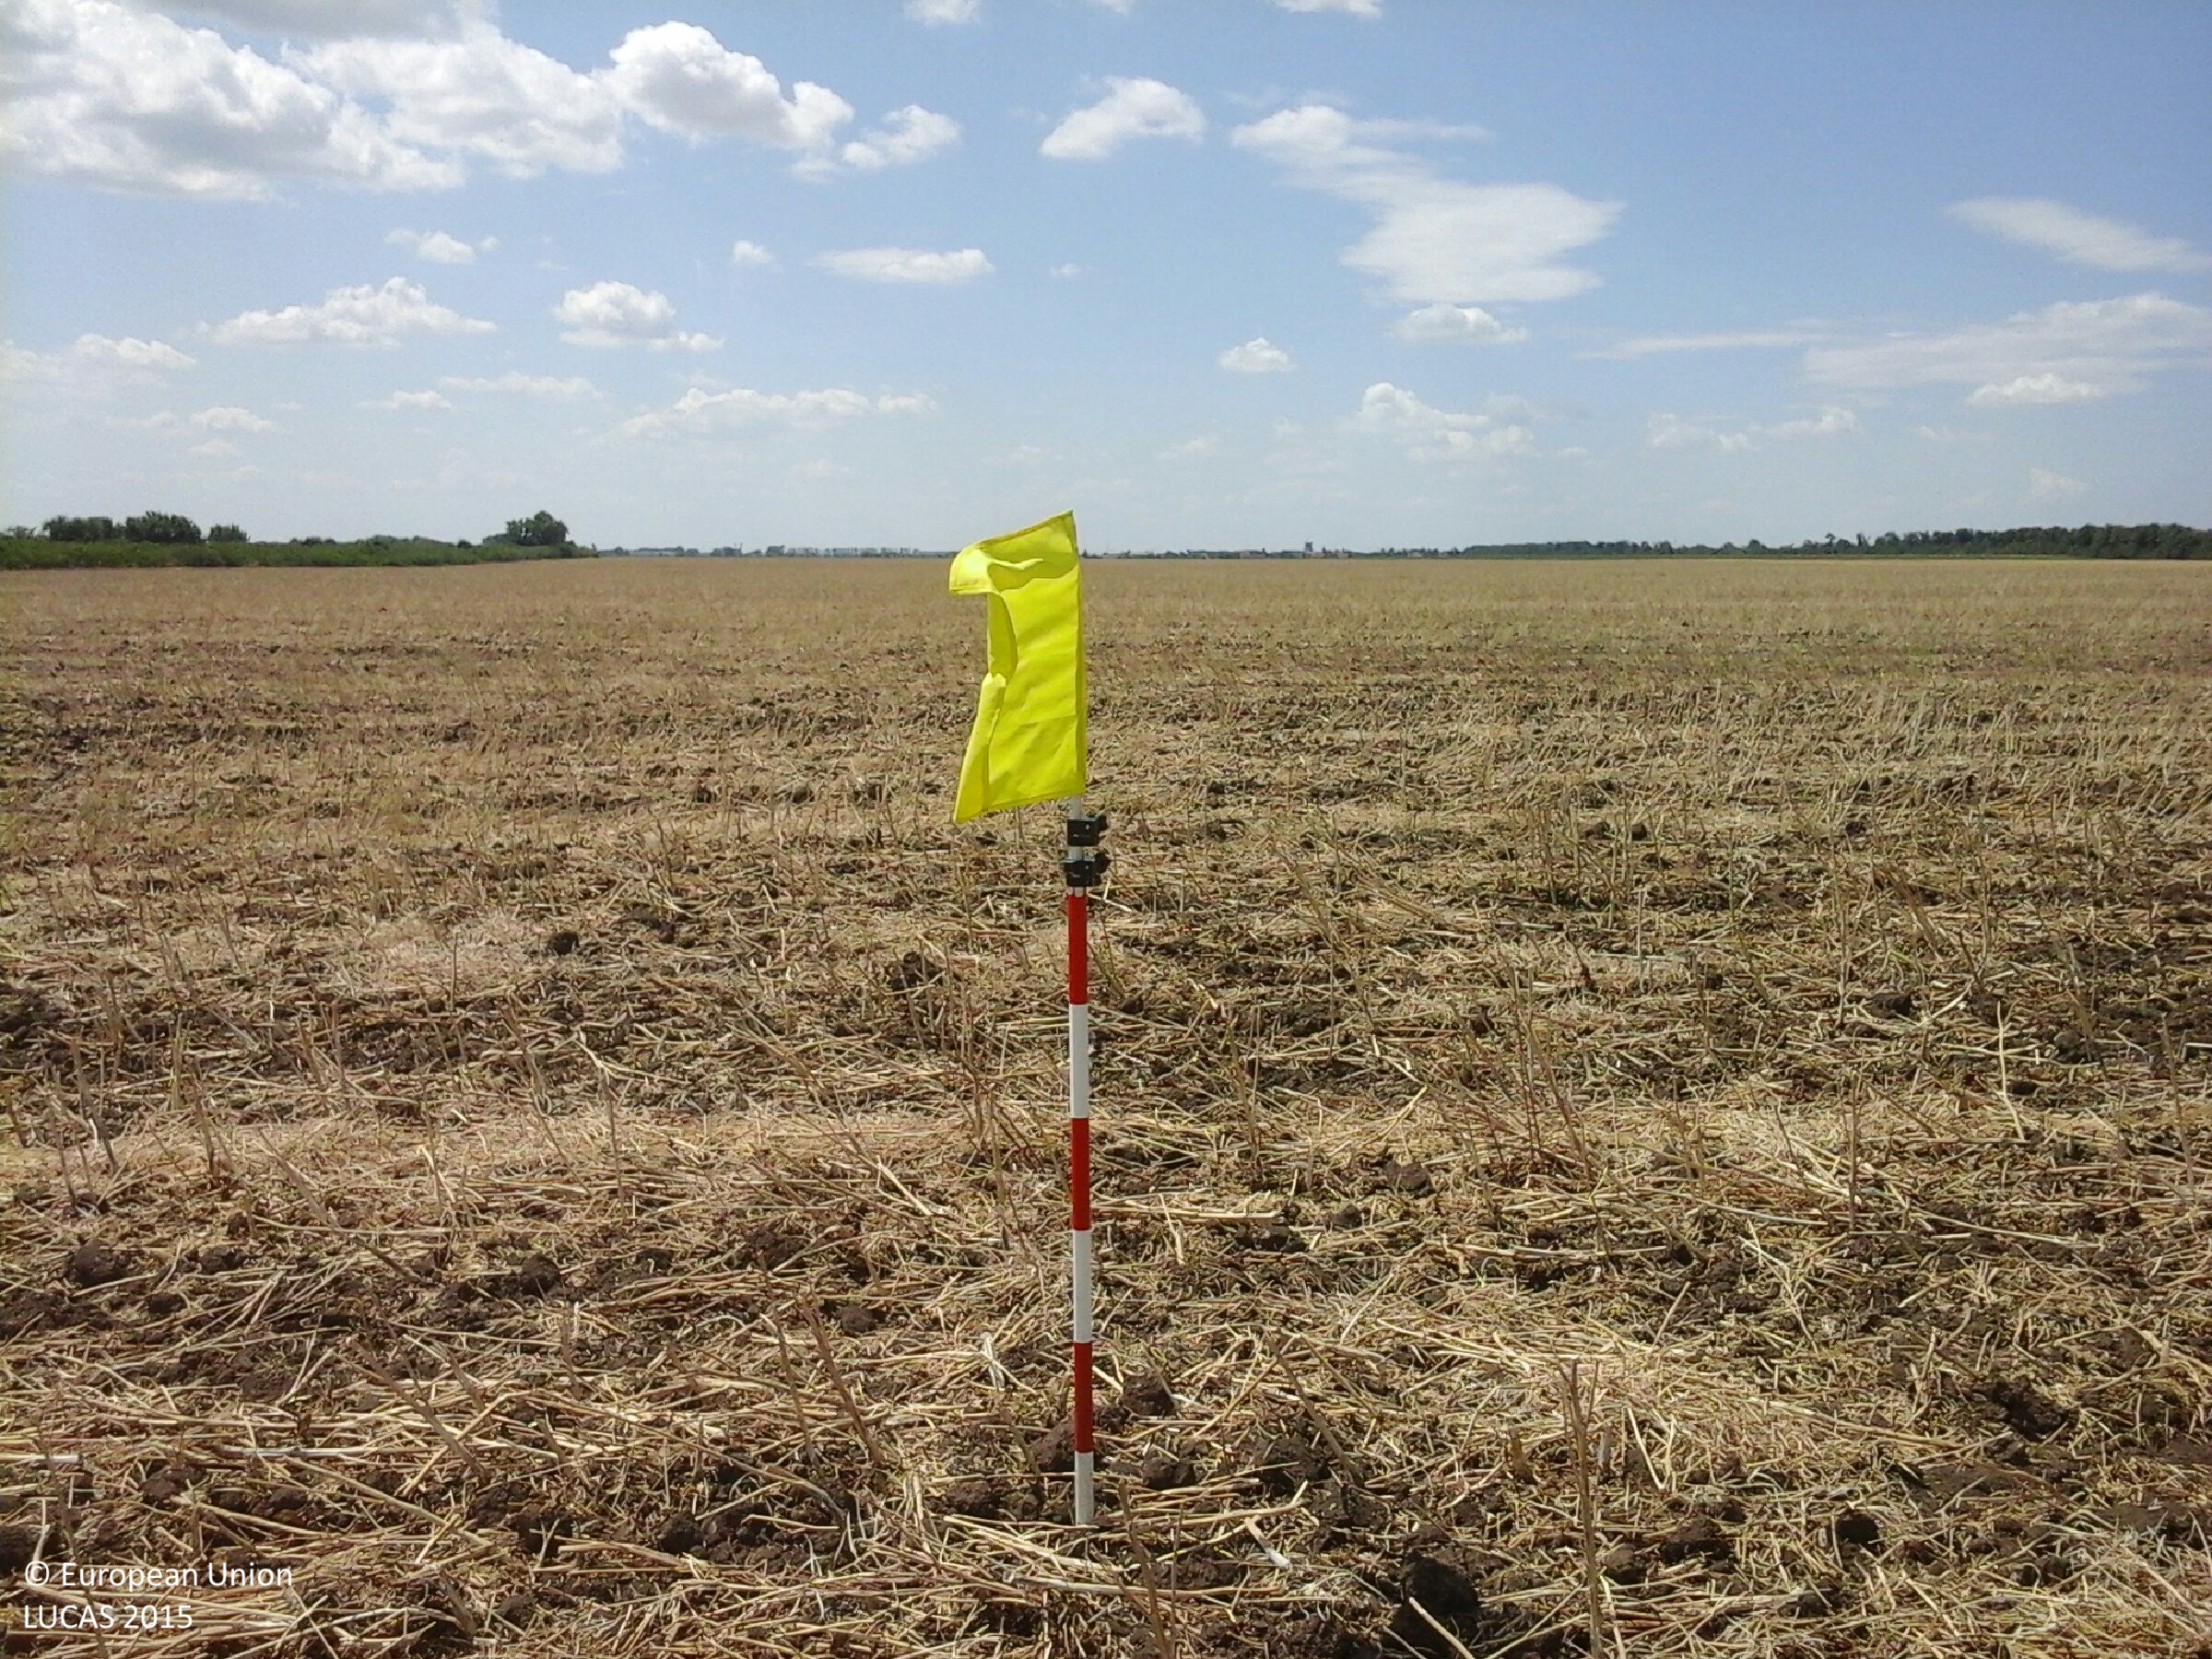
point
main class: Cropland
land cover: Rape and turnip rape
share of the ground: 25 - 50 %
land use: Agriculture (excluding fallow land and kitchen gardens)
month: July
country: HU
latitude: 47.8175
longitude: 20.6248
